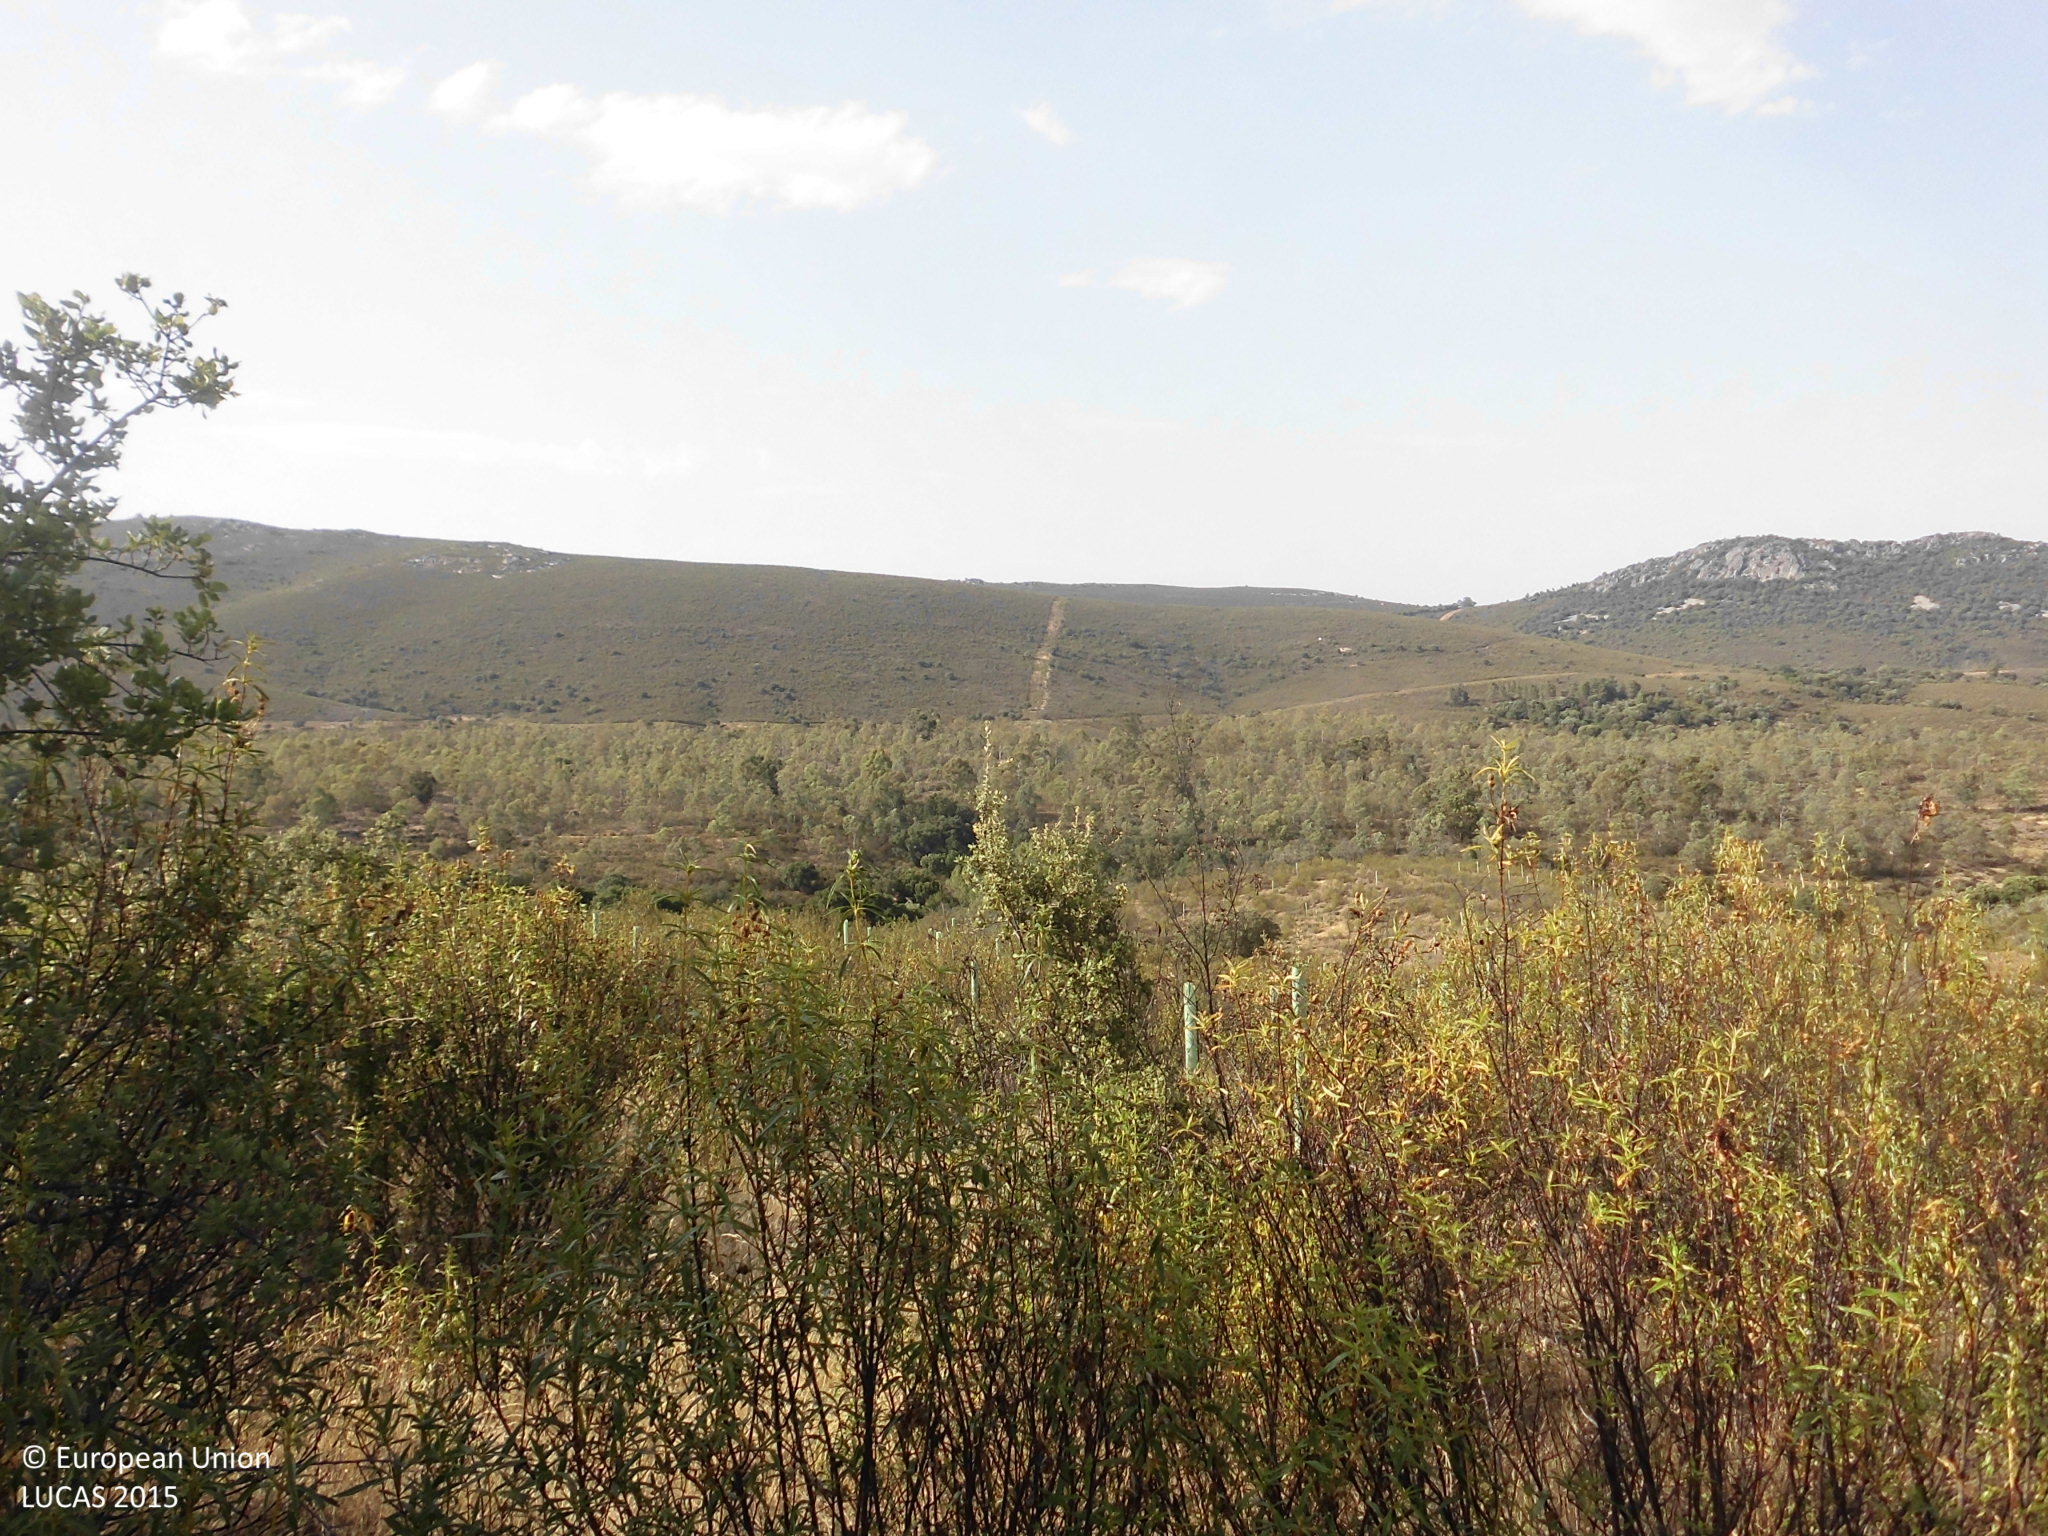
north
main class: Shrubland
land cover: Shrubland with sparse tree cover
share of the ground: > 75 %
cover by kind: shrubs 90 %, broadleaved forest trees 5 %, herbaceous plants 5 %
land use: Forestry
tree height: > 5 m
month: July
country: ES
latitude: 39.6520
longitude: -5.6150
